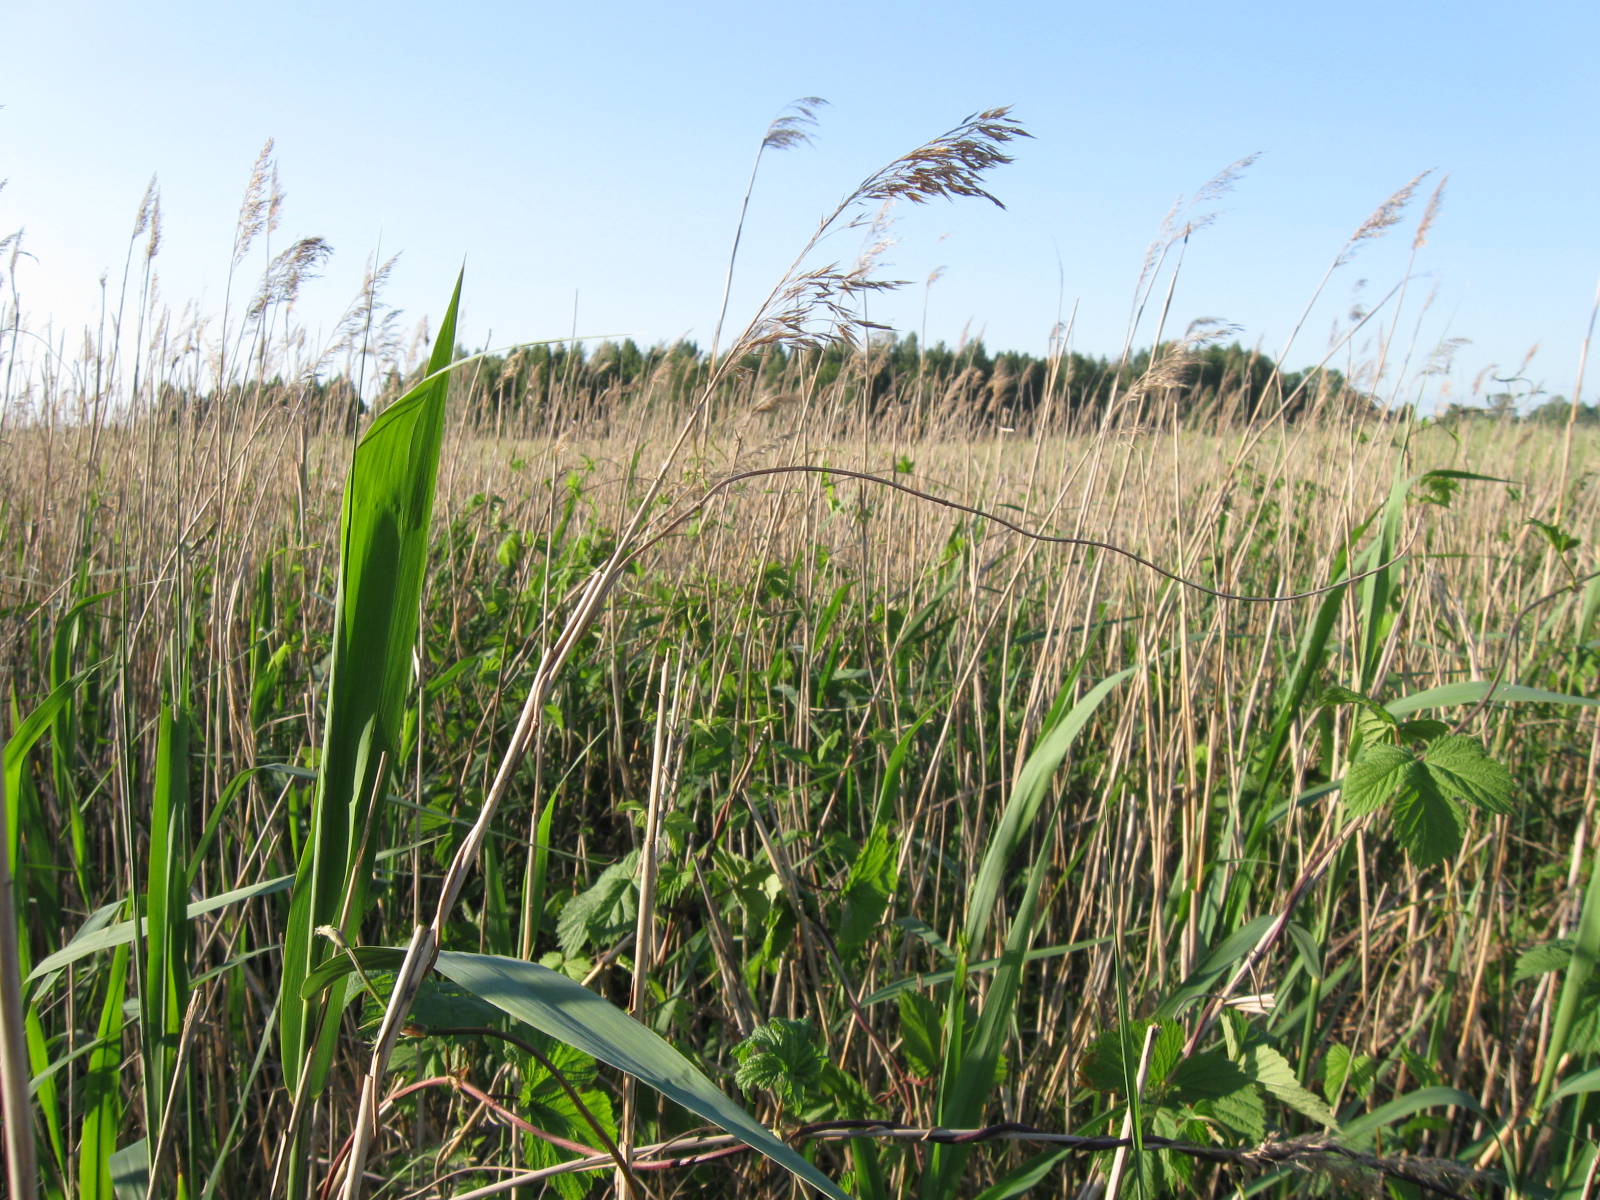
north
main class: Grassland
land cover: Spontaneously vegetated surfaces
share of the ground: > 75 %
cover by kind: herbaceous plants 100 %
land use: Semi-natural and natural areas not in use
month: June
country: LT
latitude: 54.4265
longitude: 23.8536
